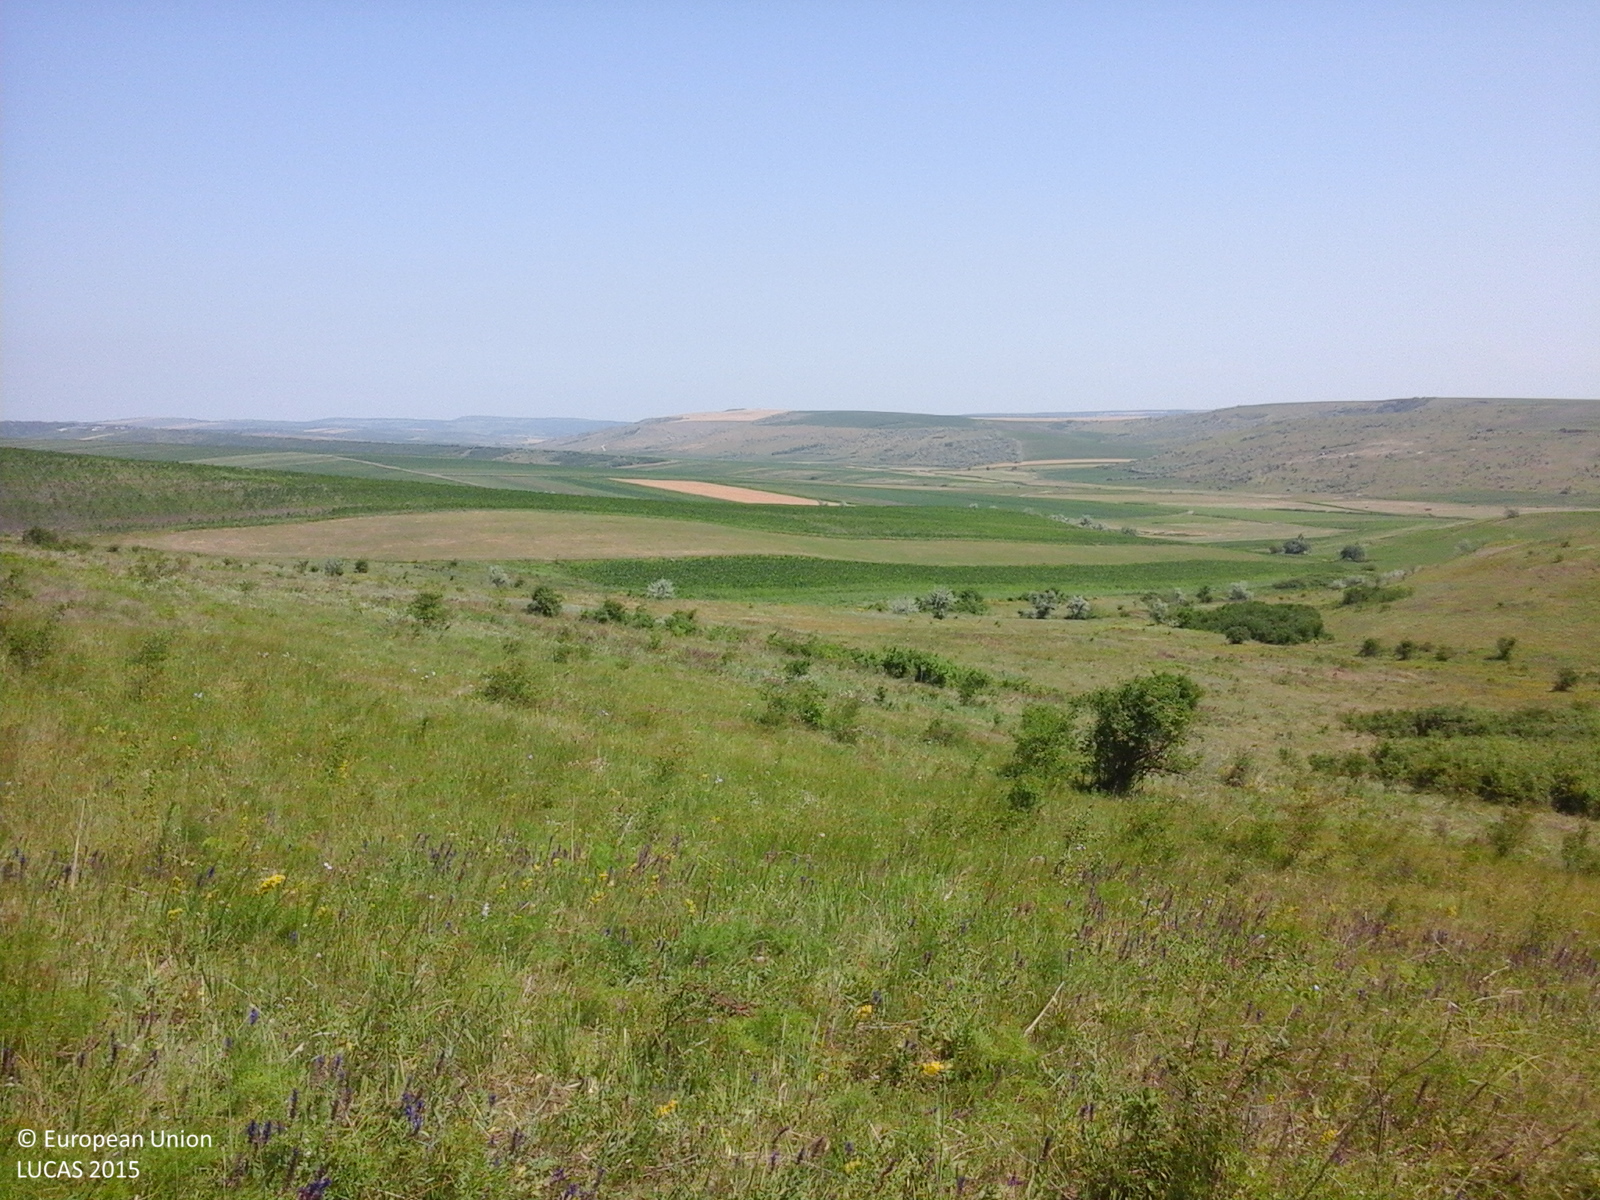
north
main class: Grassland
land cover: Grassland with sparse tree/shrub cover
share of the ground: > 75 %
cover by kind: herbaceous plants 85 %, shrubs 10 %, broadleaved forest trees 5 %
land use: Semi-natural and natural areas not in use
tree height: < 5 m
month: June
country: RO
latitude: 46.6225
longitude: 27.8443
